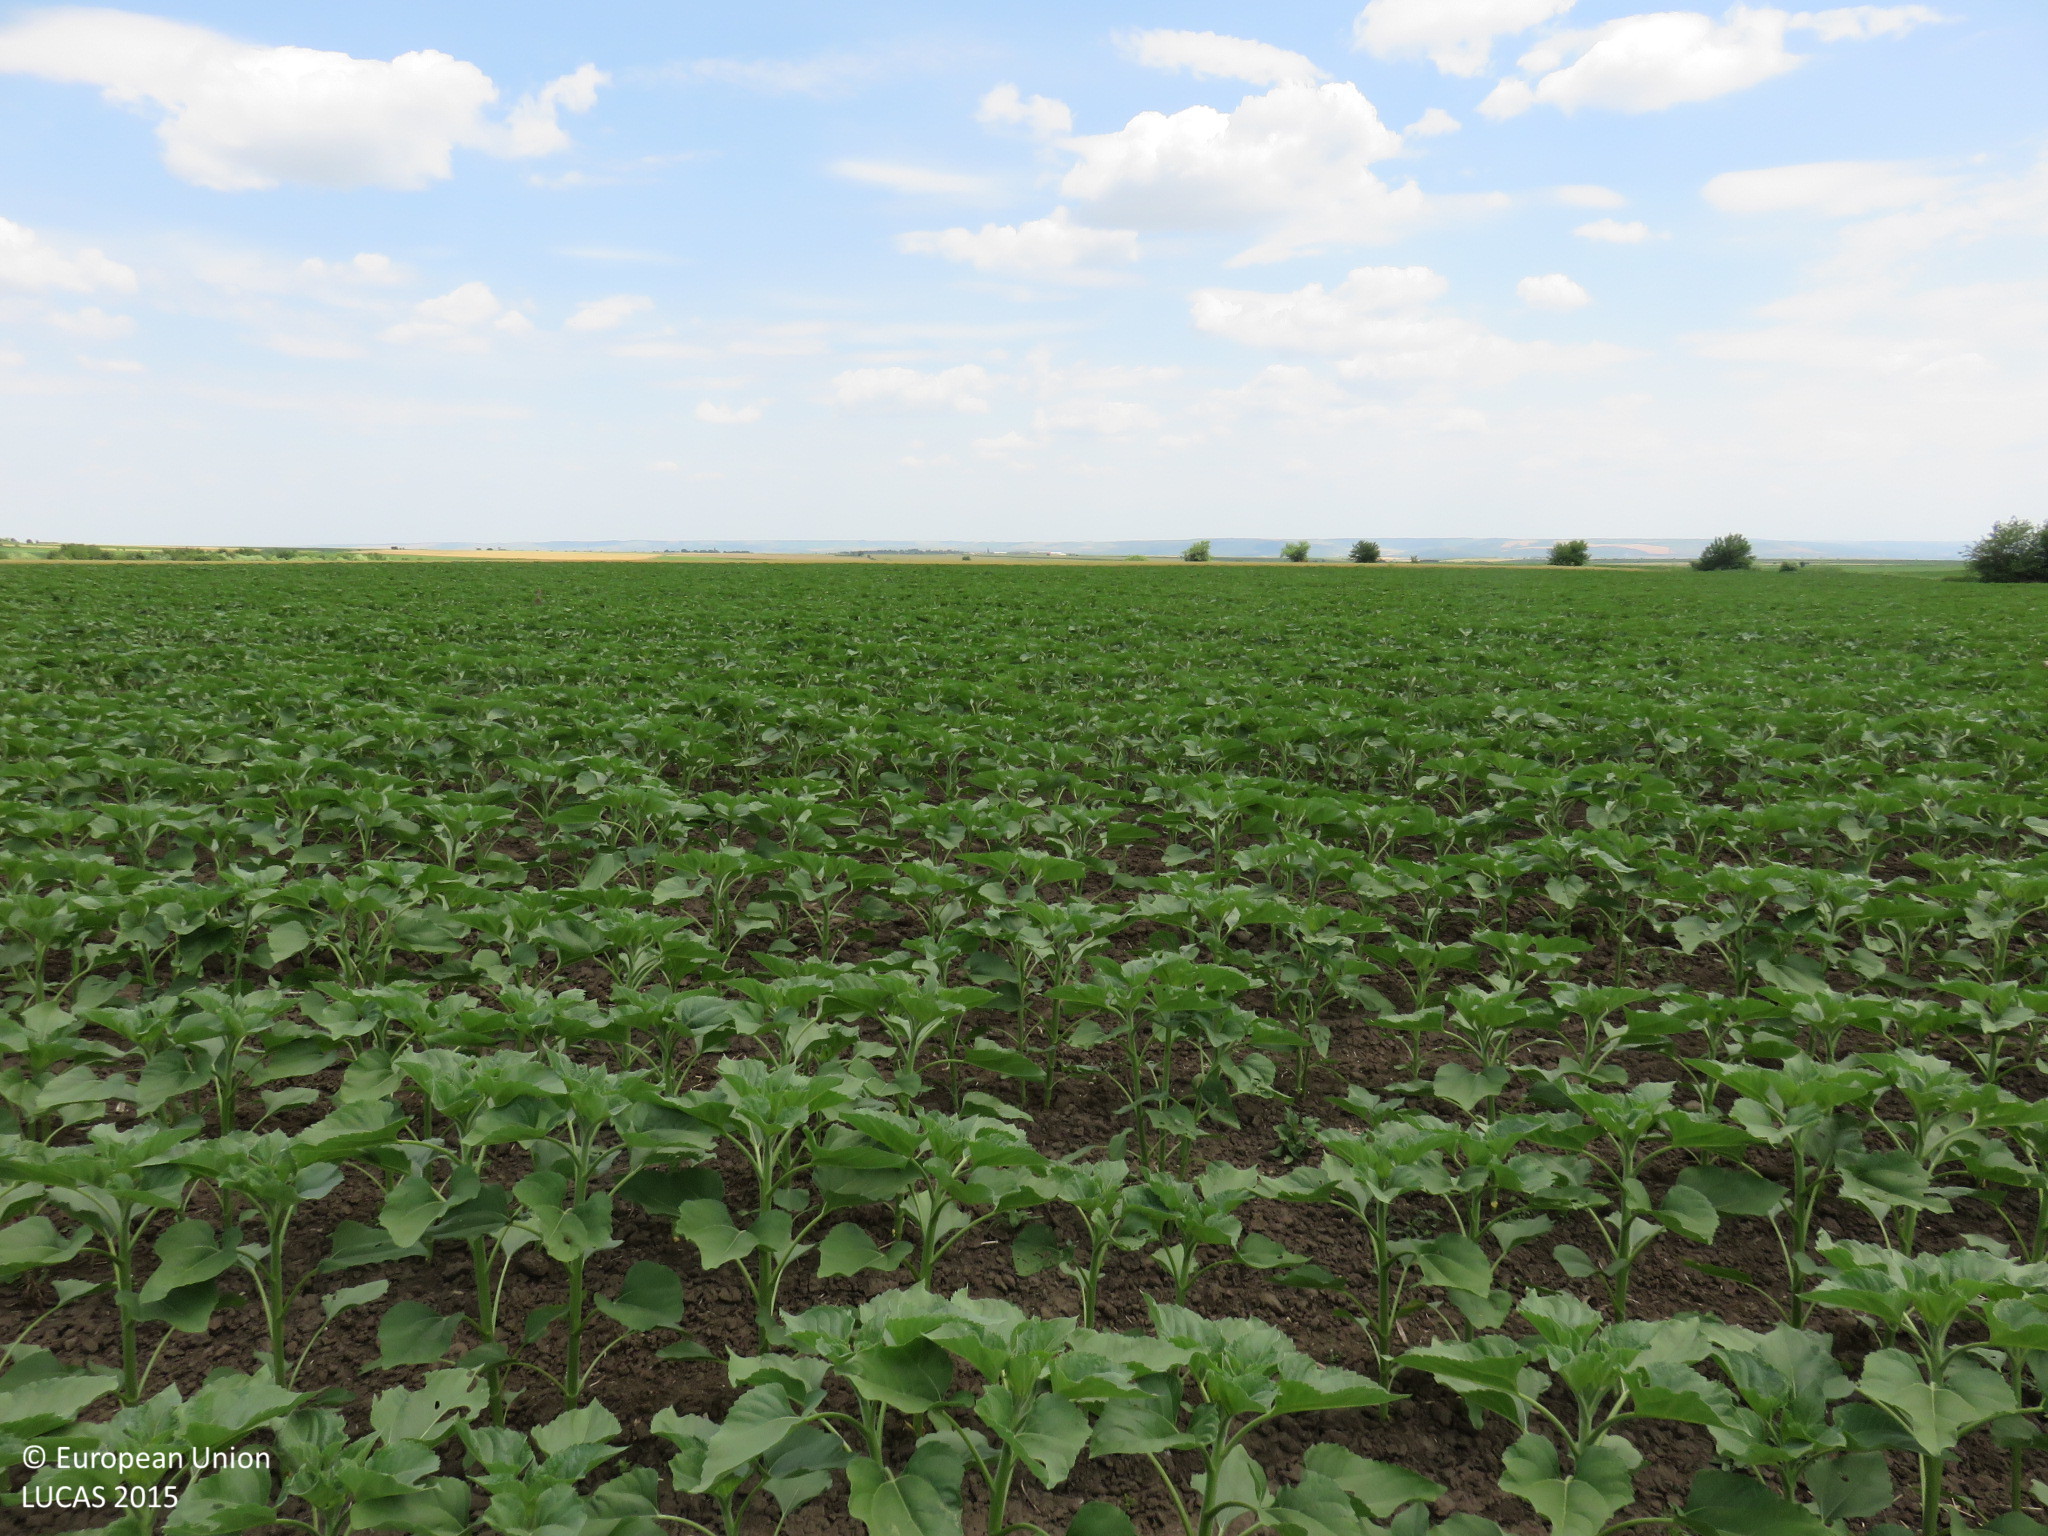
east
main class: Cropland
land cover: Sunflower
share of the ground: > 75 %
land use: Agriculture (excluding fallow land and kitchen gardens)
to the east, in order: Sunflower; Grass margins; Common wheat; Grass margins; Maize
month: June
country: BG
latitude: 43.5020
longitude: 24.4193
